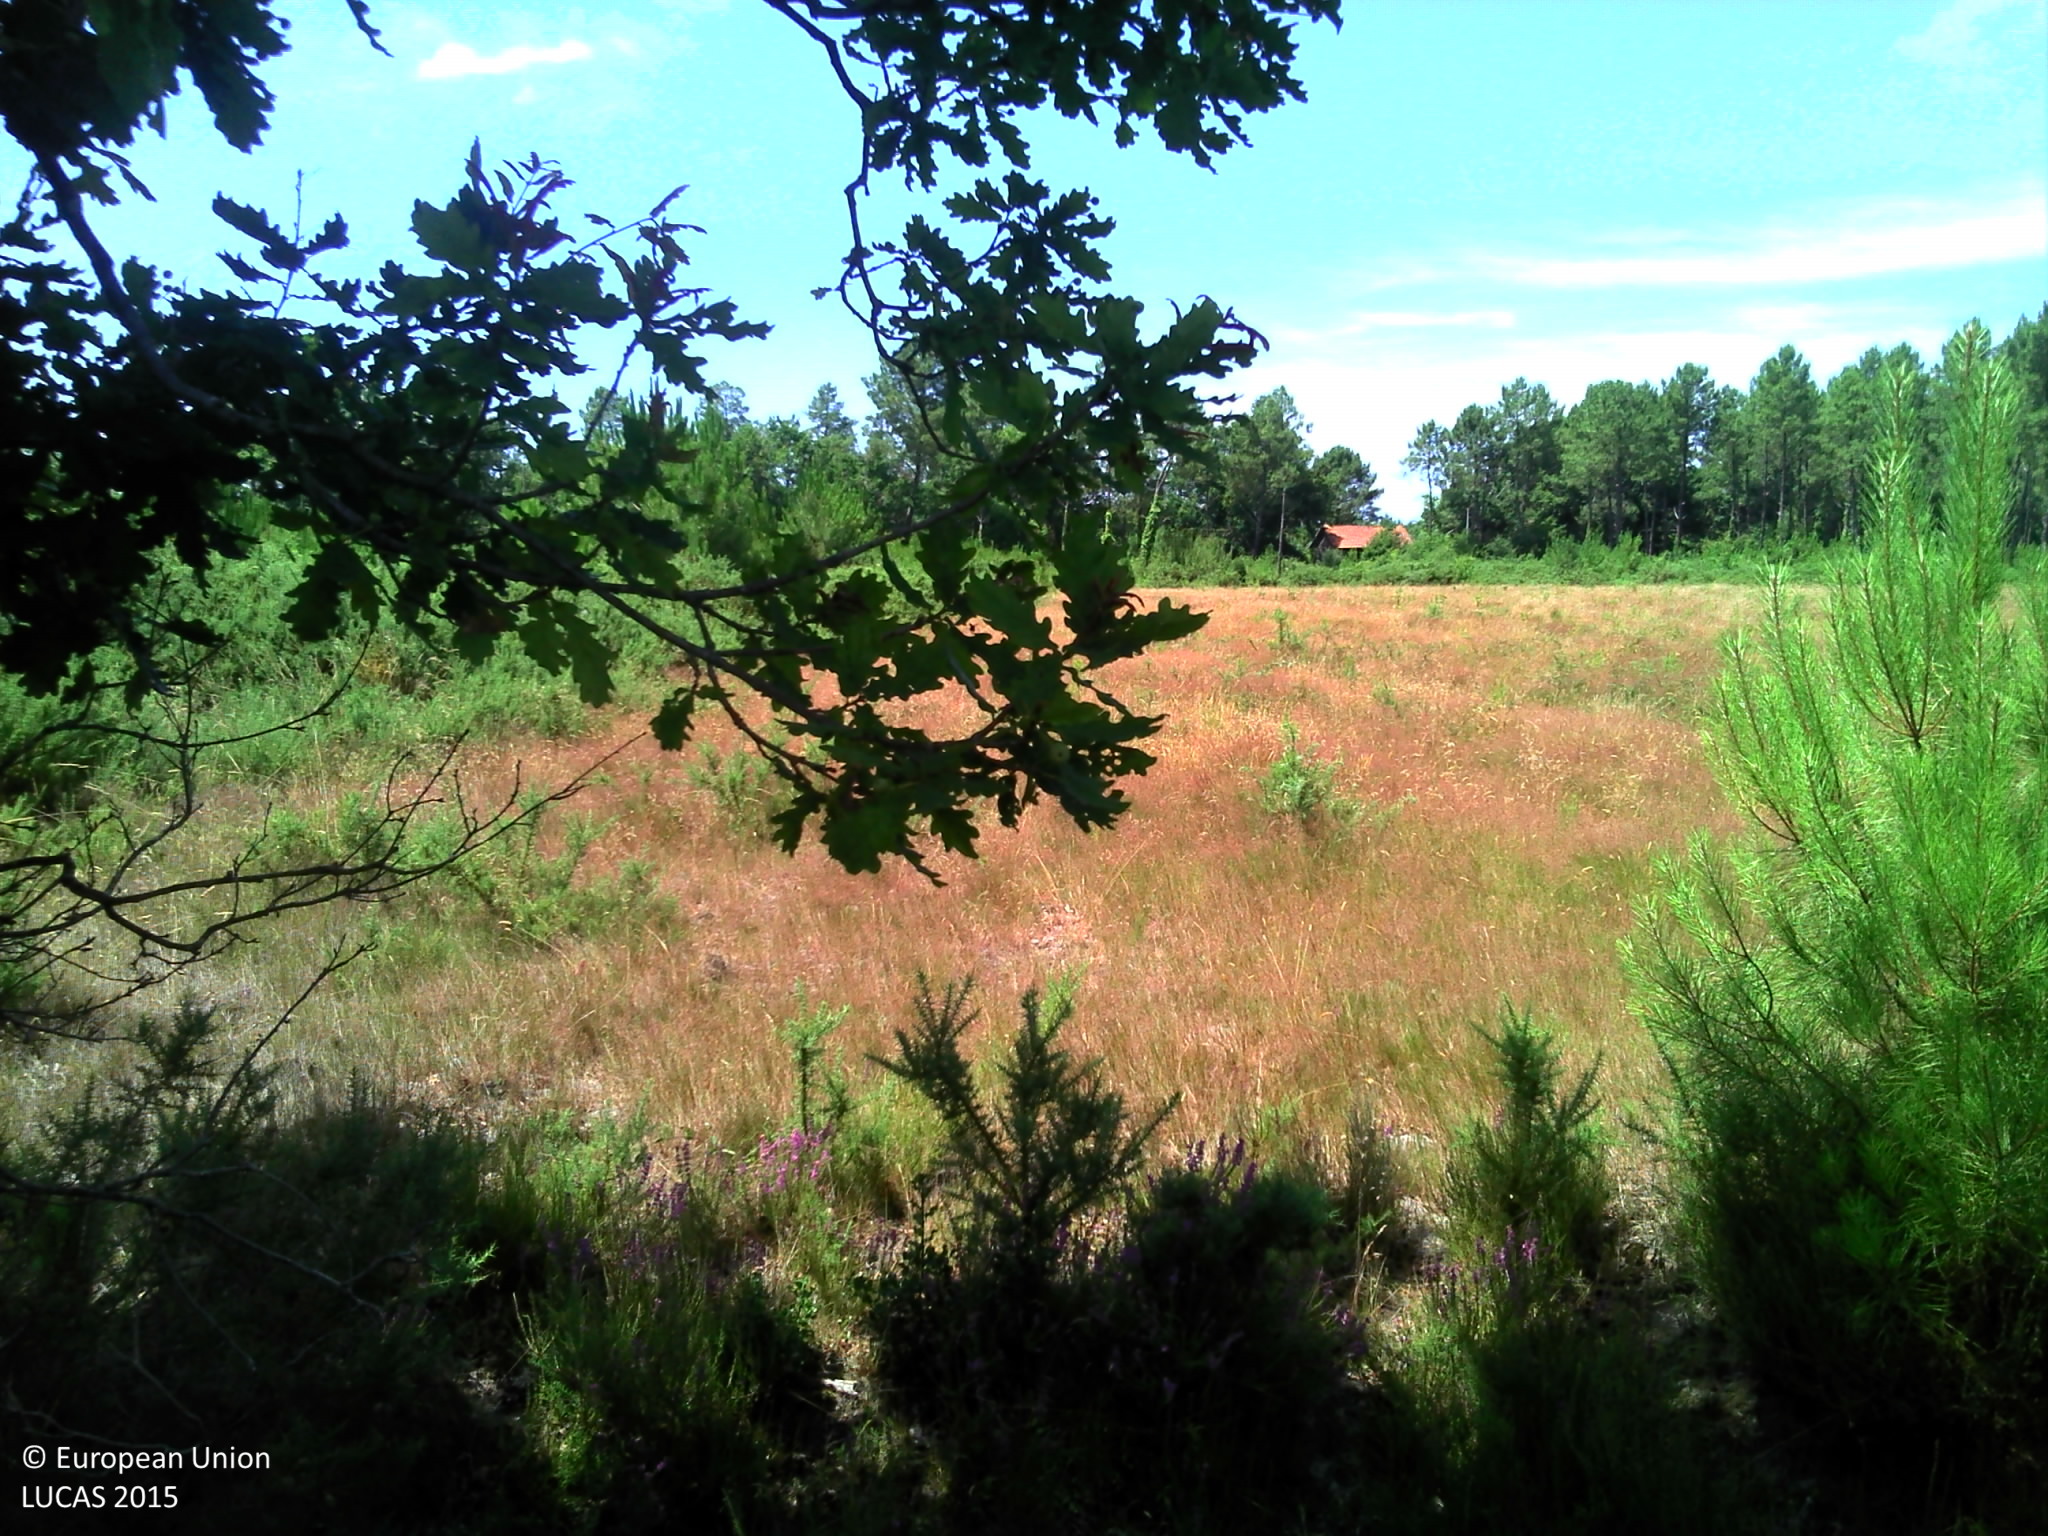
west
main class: Woodland
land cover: Pine dominated mixed woodland
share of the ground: > 75 %
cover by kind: coniferous forest trees 40 %, broadleaved forest trees 40 %, shrubs 10 %, herbaceous plants 10 %
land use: Forestry
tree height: > 5 m
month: July
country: FR
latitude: 43.9787
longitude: -1.2014
